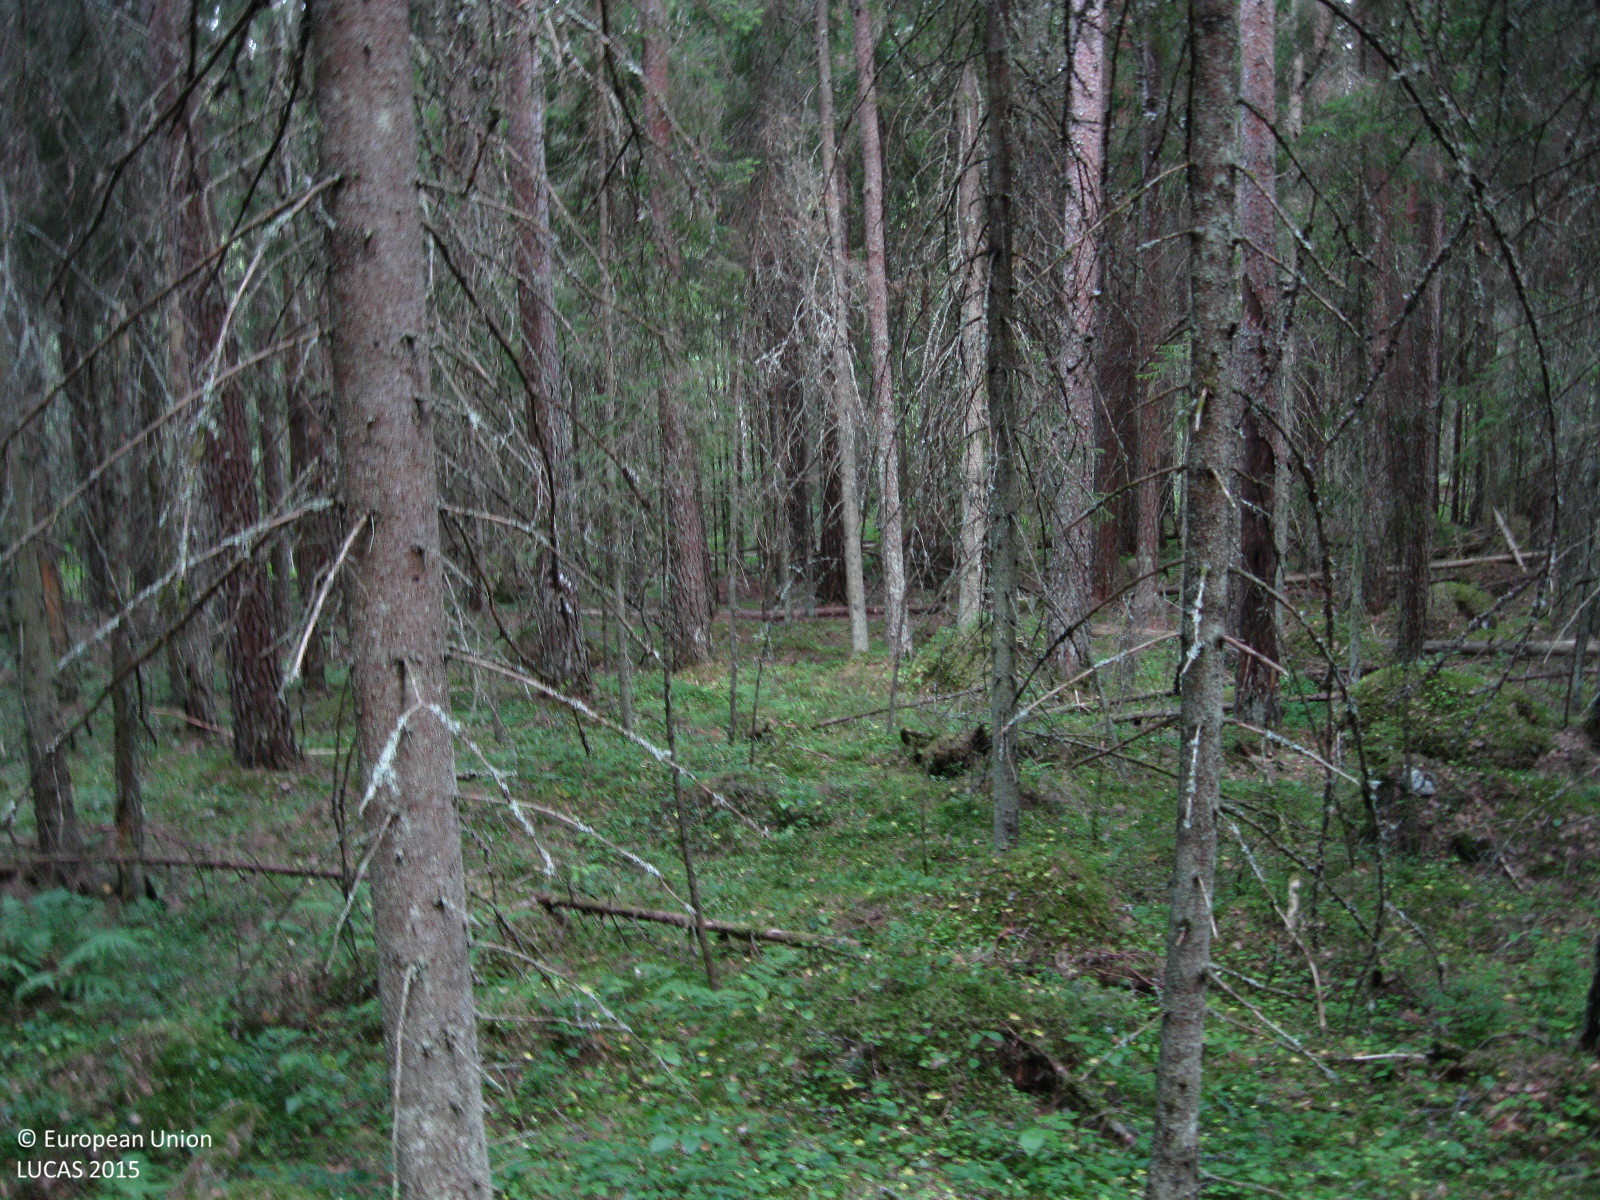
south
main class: Woodland
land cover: Other coniferous woodland
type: boreal forest
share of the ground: > 75 %
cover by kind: coniferous forest trees 85 %, herbaceous plants 10 %, broadleaved forest trees 5 %
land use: Forestry
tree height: > 5 m
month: August
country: FI
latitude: 61.3057
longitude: 25.1440
